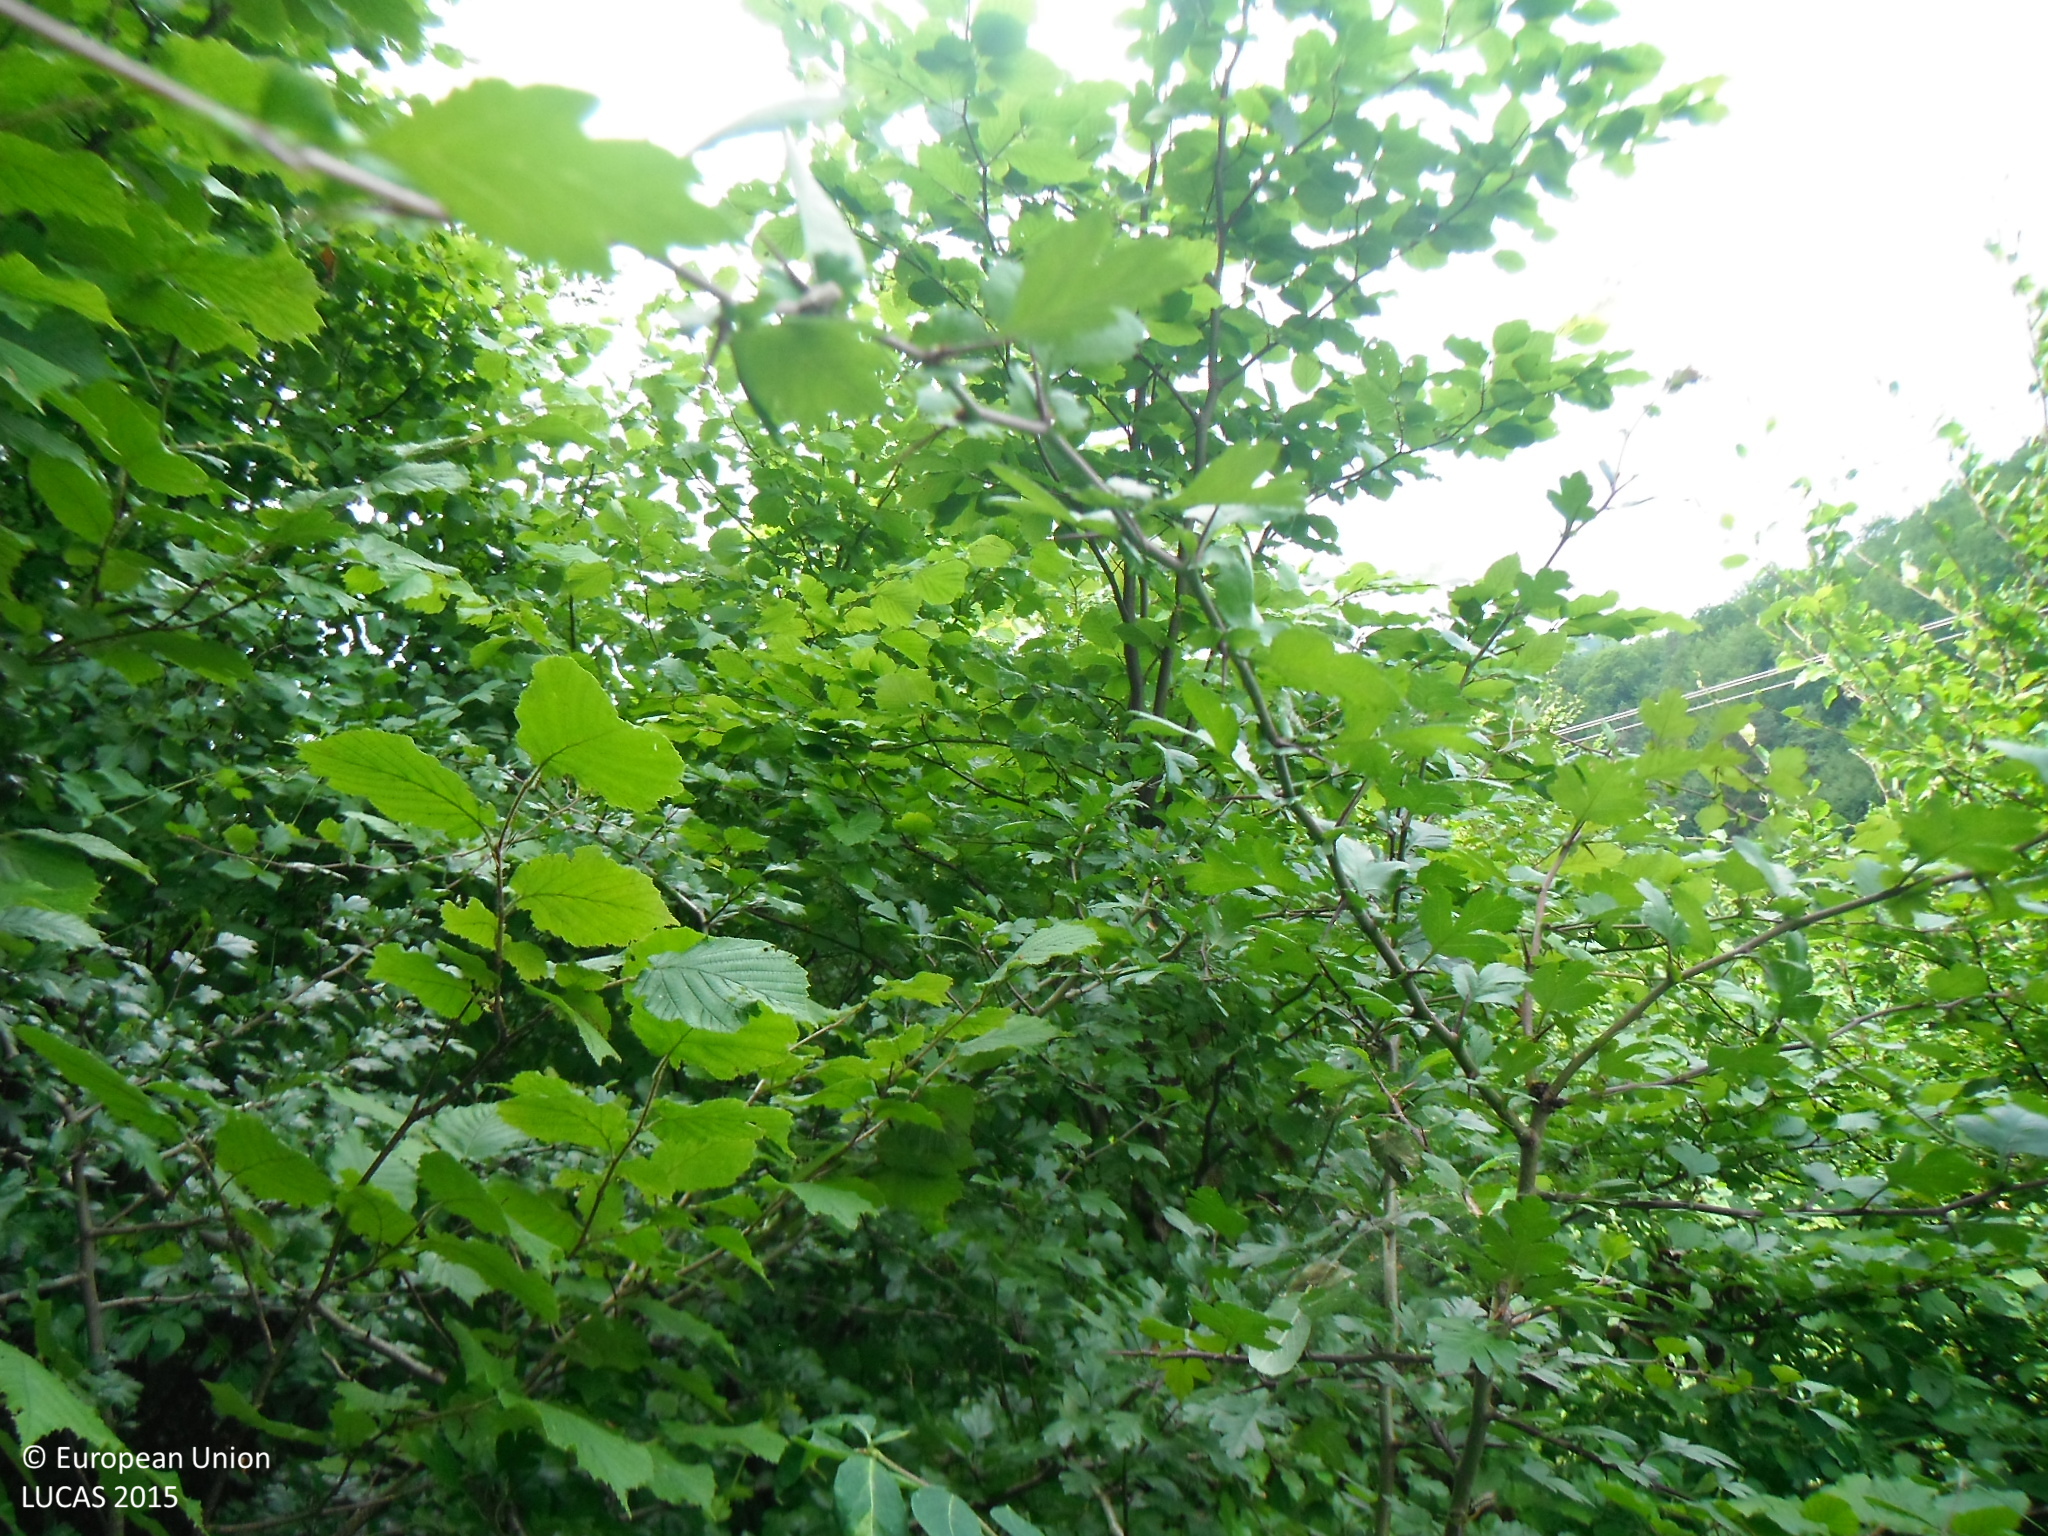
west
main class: Shrubland
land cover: Shrubland with sparse tree cover
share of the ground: > 75 %
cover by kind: shrubs 85 %, herbaceous plants 10 %, broadleaved forest trees 5 %
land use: Semi-natural and natural areas not in use
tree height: > 5 m
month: July
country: SK
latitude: 49.0987
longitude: 18.6061
